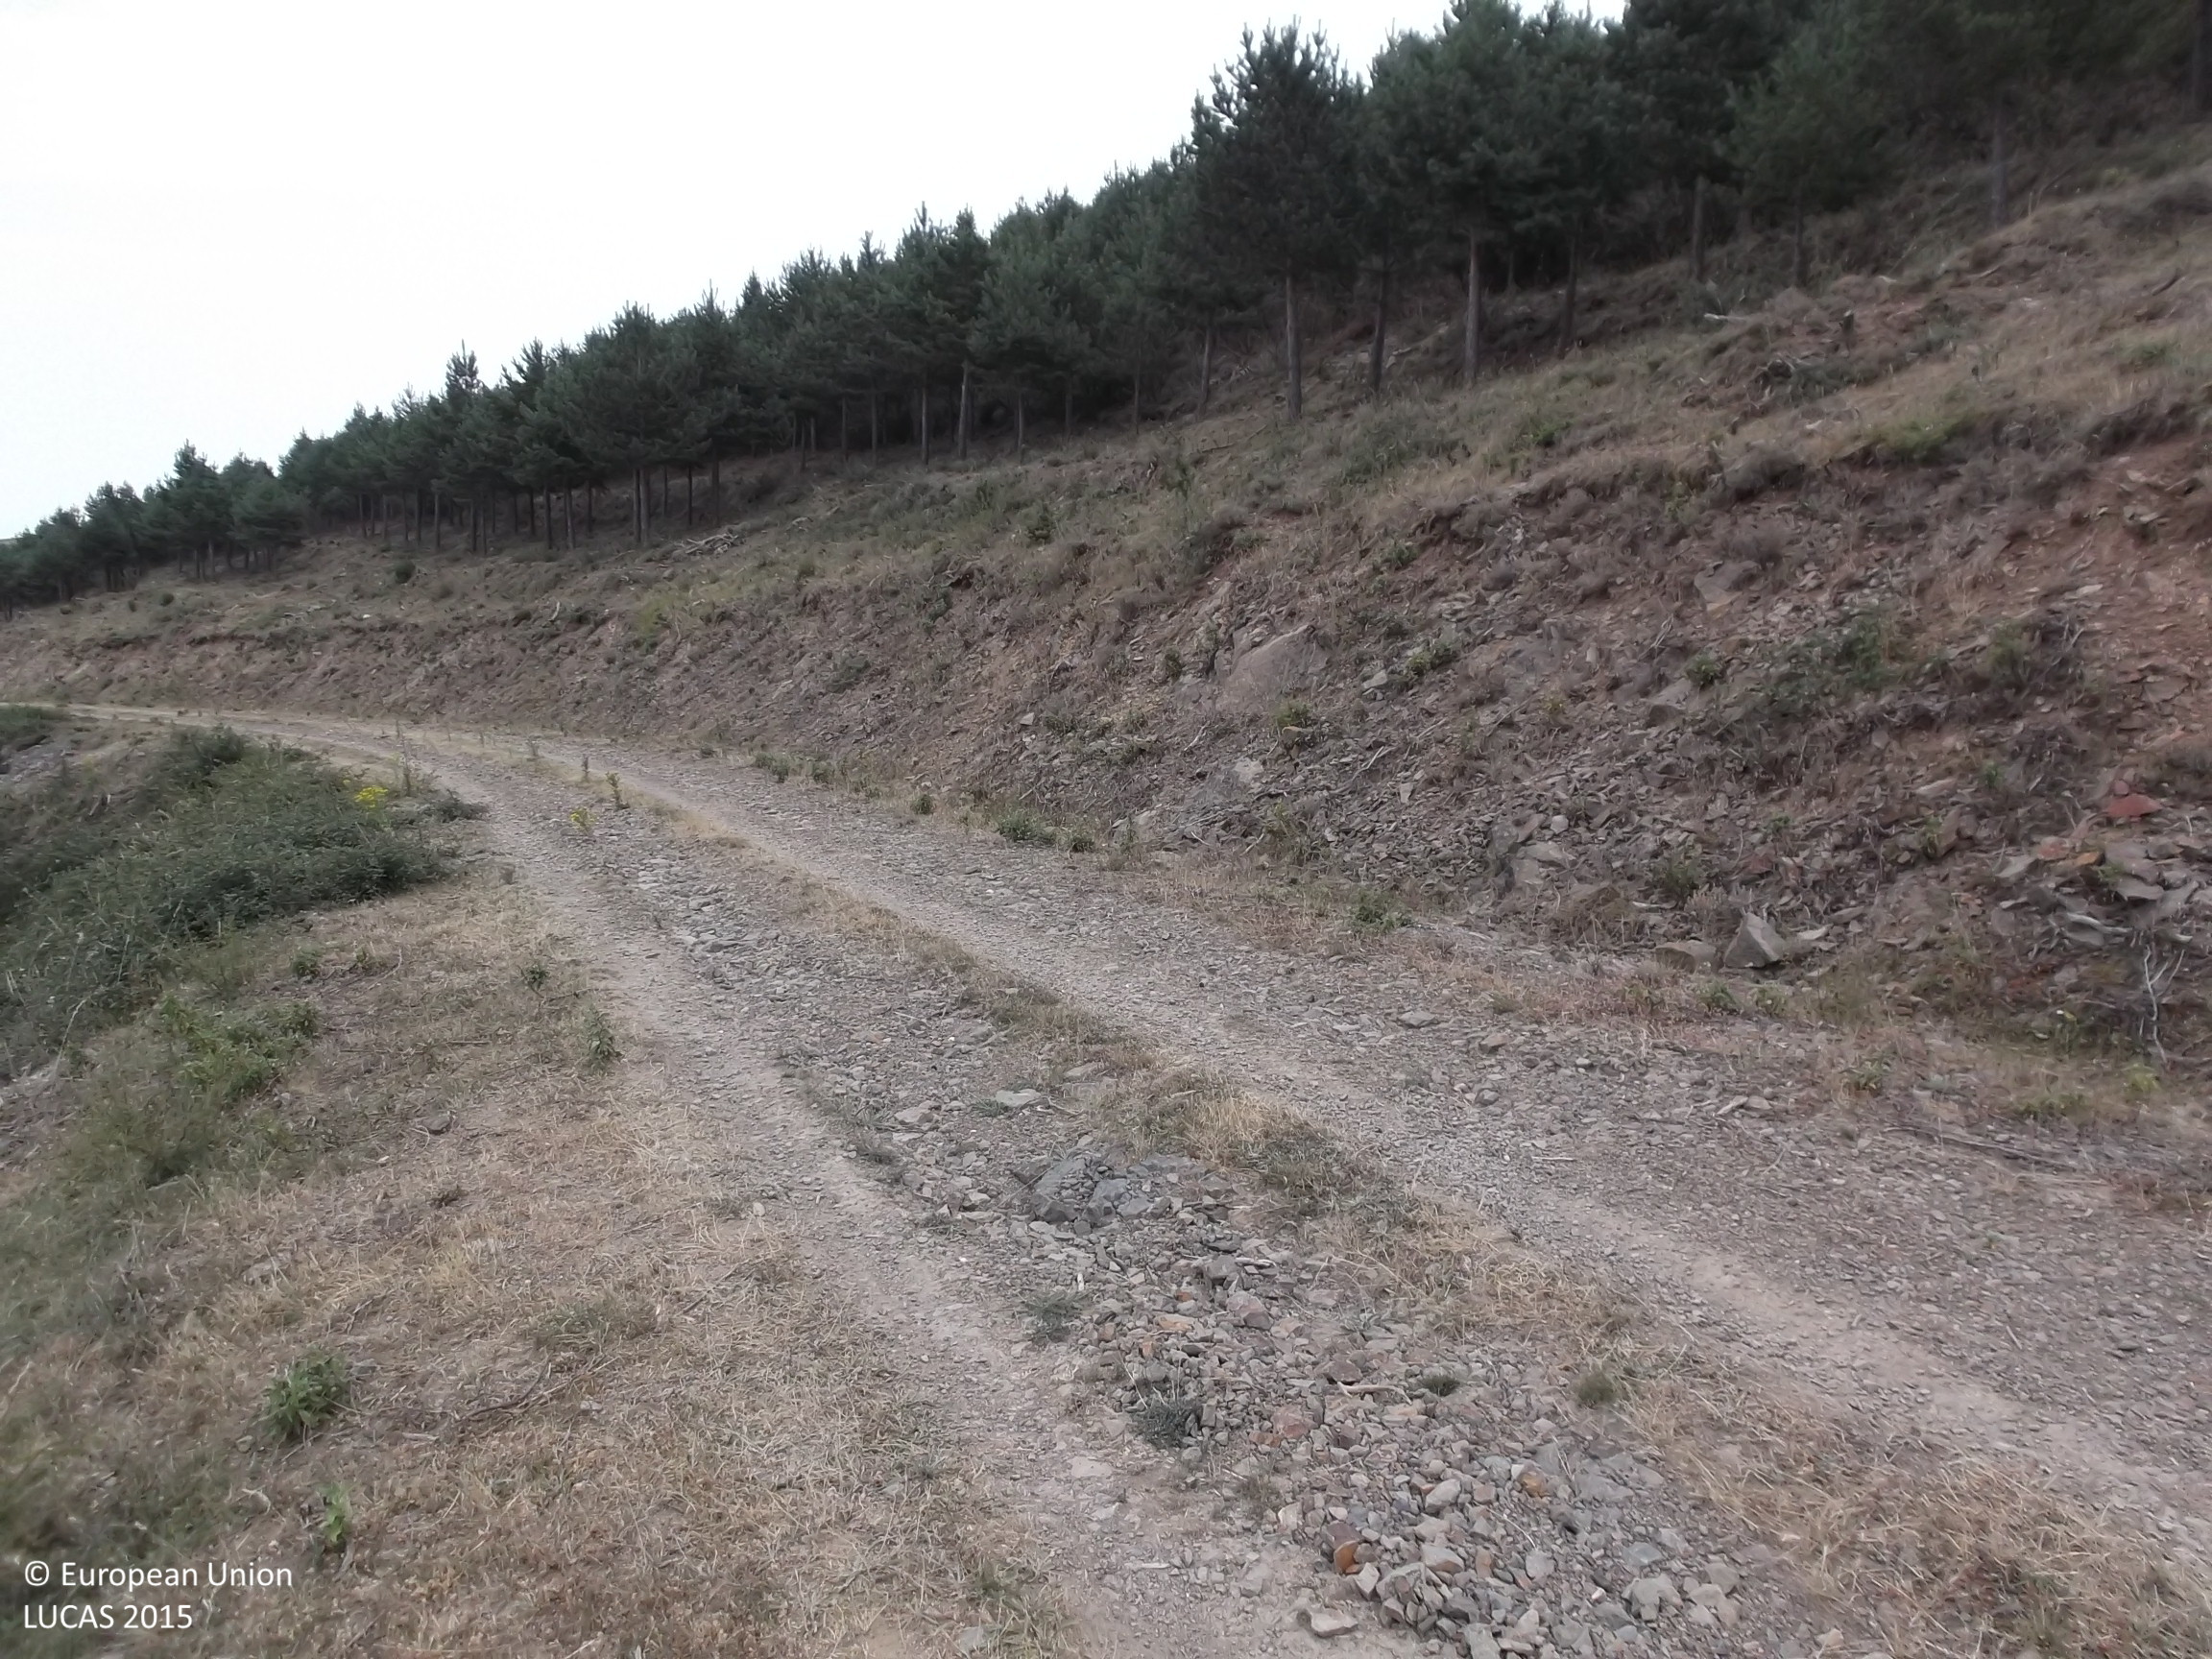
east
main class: Woodland
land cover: Pine dominated coniferous woodland
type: coniferous forest of the mediterranean region
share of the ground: > 75 %
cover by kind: coniferous forest trees 80 %, shrubs 20 %
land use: Forestry
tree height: < 5 m
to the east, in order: Pine dominated coniferous woodland; Shrubland without tree cover; Grassland with sparse tree/shrub cover; Tracks; Grassland with sparse tree/shrub cover; Shrubland without tree cover; Pine dominated coniferous woodland
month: July
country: ES
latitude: 42.0169
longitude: -2.1004
